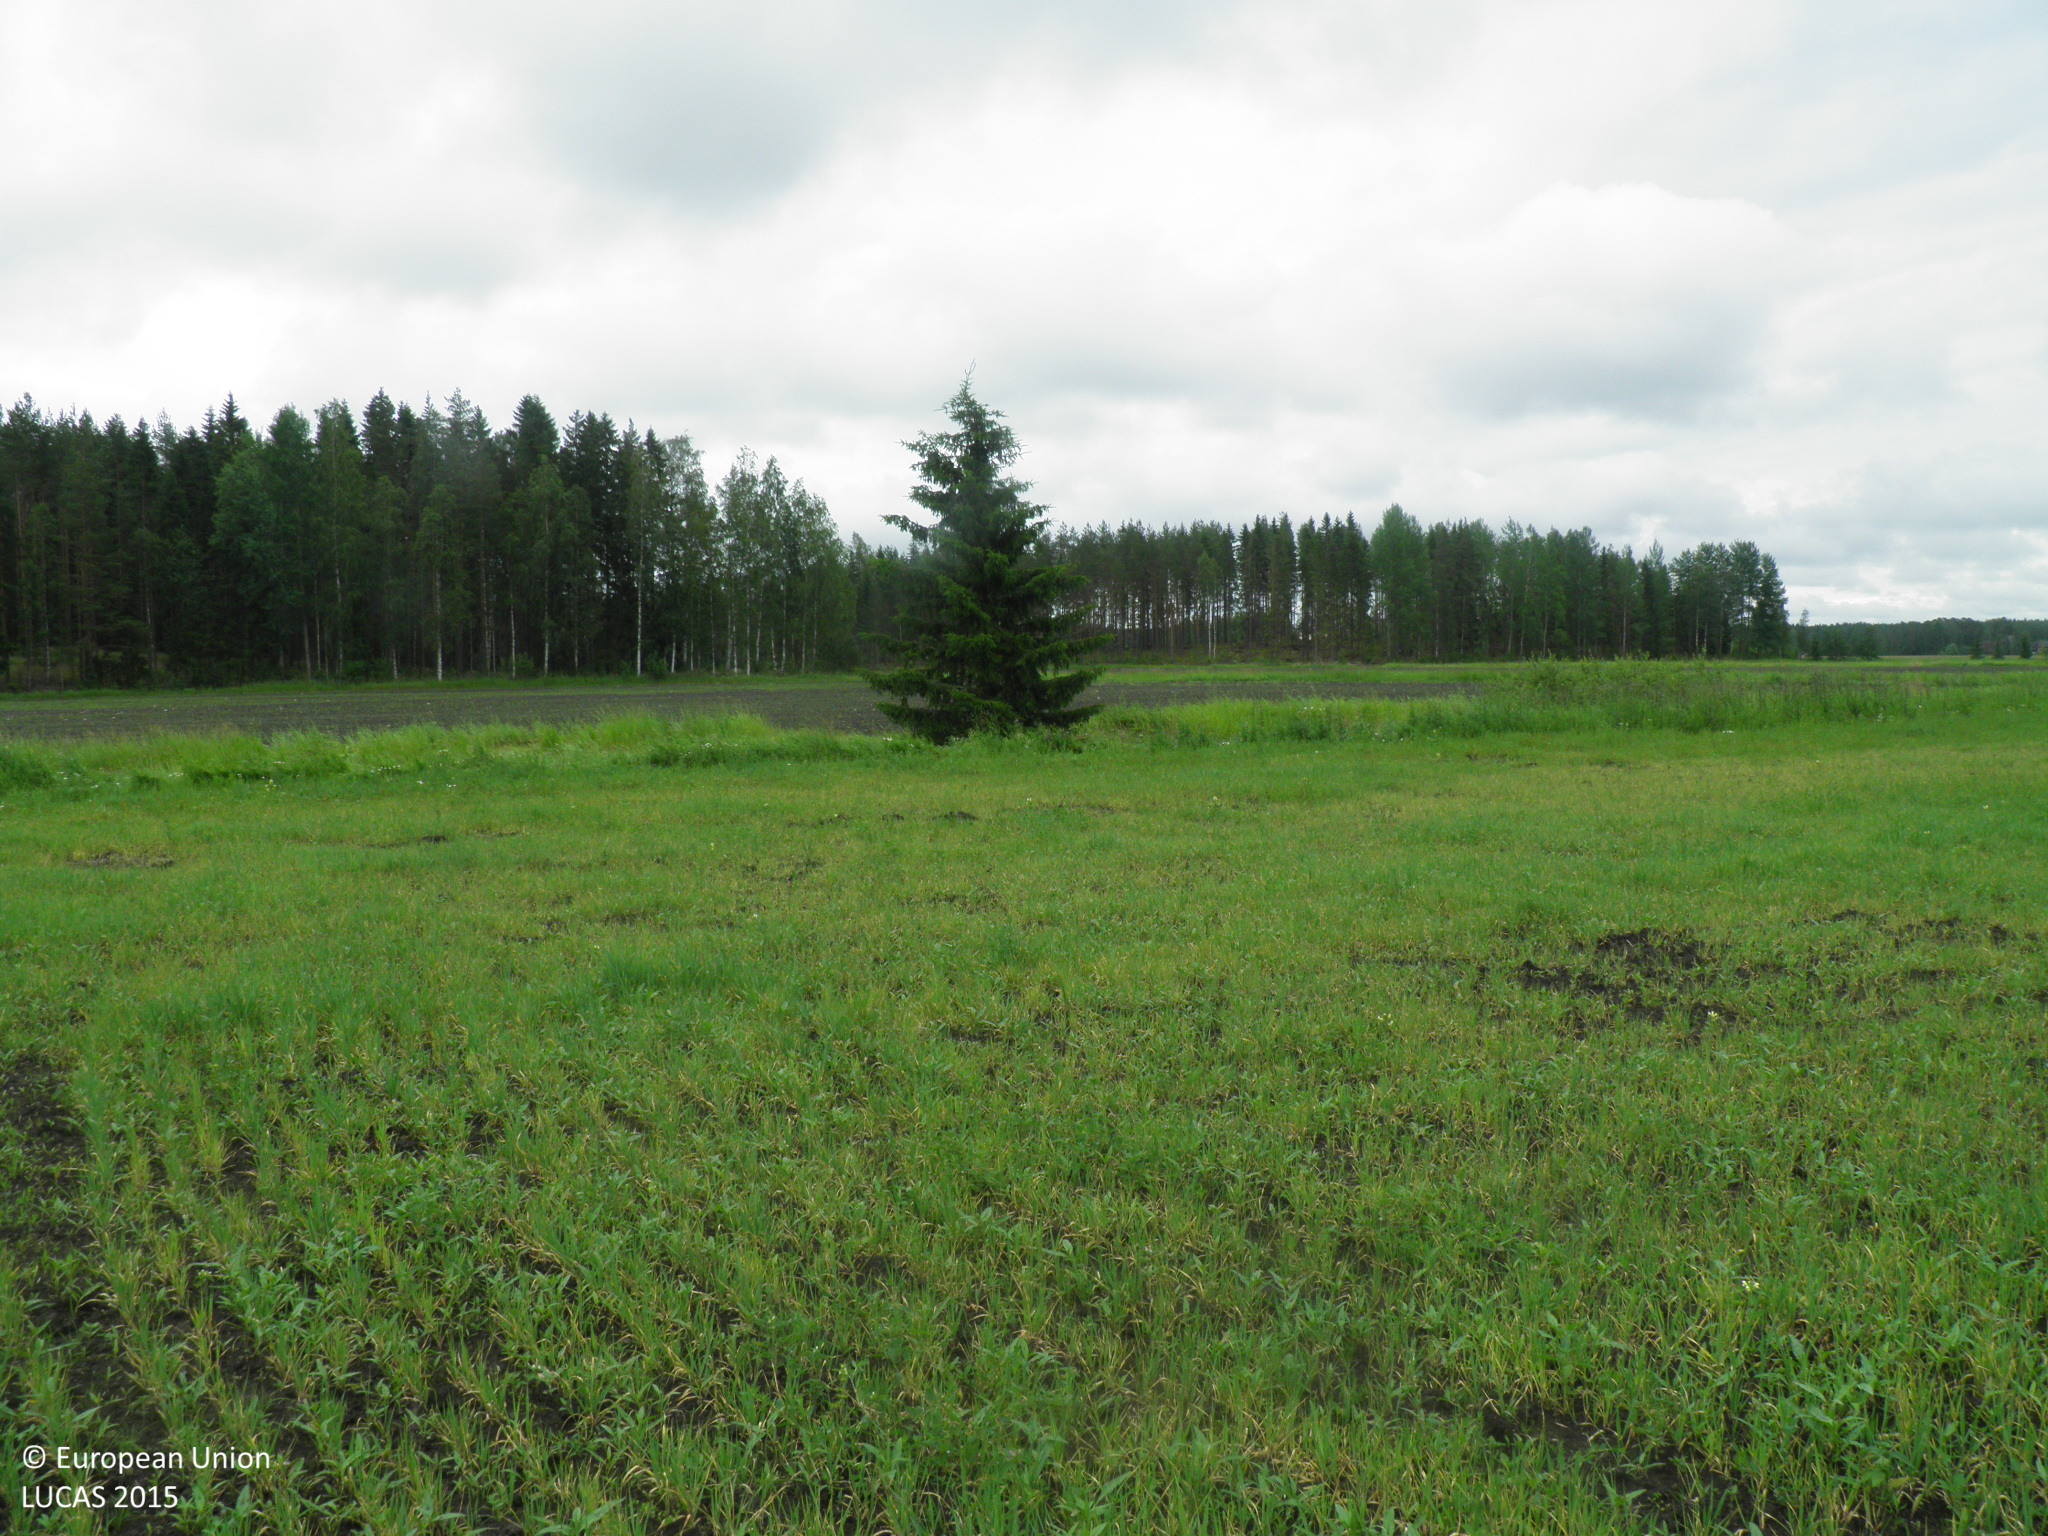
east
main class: Cropland
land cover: Barley
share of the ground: > 75 %
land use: Agriculture (excluding fallow land and kitchen gardens)
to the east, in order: Barley; Grass margins; Ditches and canals; Grass margins; Other bare soil; Grass margins; Ditches and canals; Grass margins; Other bare soil; Grass margins; Ditches and canals; Pine dominated mixed woodland; Tracks
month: July
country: FI
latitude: 60.6621
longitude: 22.7156
